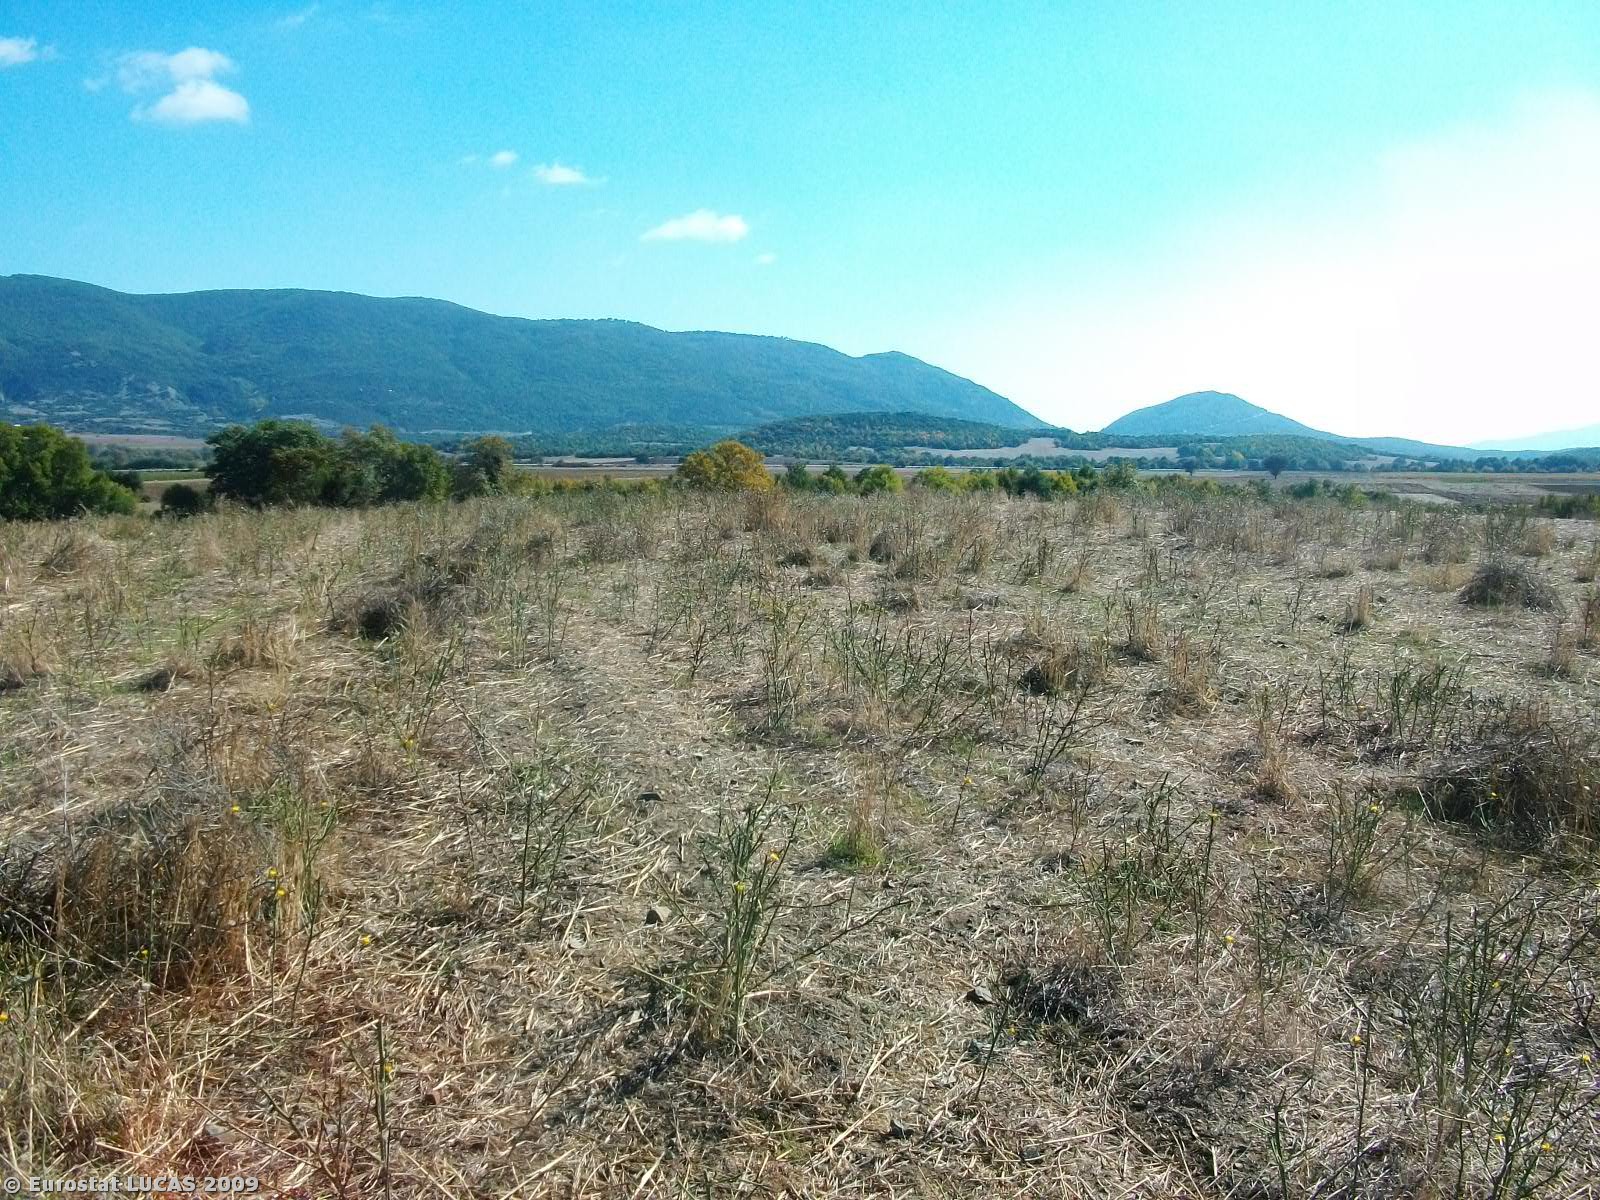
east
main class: Grassland
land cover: Spontaneously vegetated surfaces
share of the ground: > 75 %
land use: Fallow land
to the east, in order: Spontaneously vegetated surfaces; Sunflower; Broadleaved woodland
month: October
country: GR
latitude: 40.7293
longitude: 23.5731
